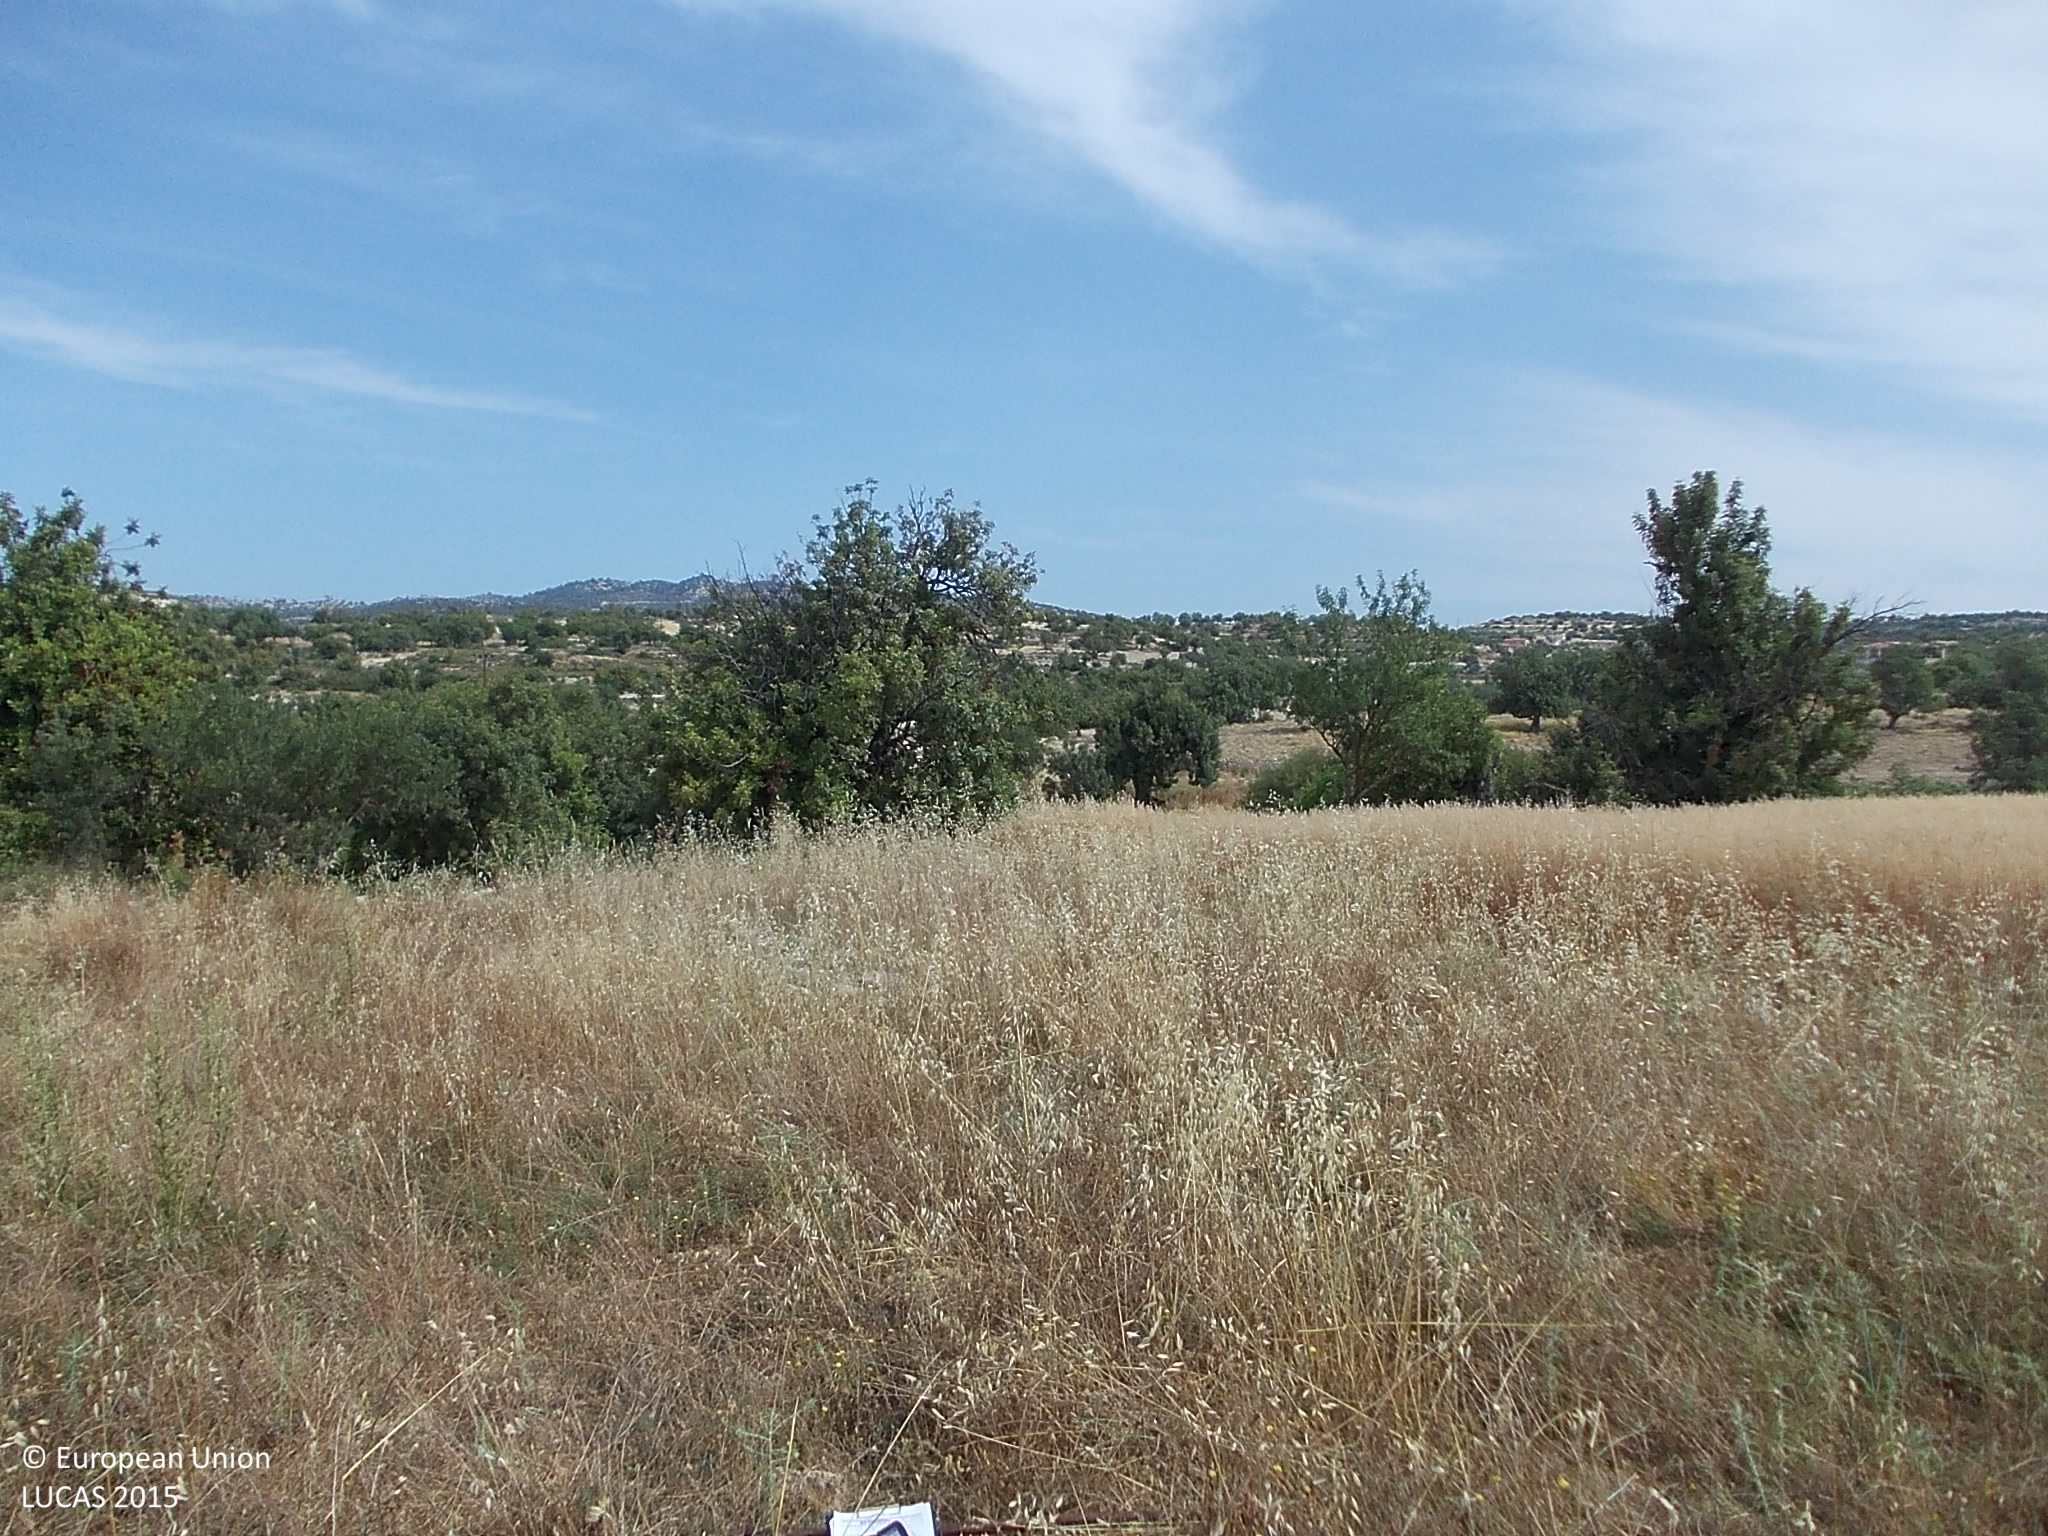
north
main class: Grassland
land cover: Spontaneously vegetated surfaces
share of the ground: > 75 %
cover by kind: herbaceous plants 90 %, unconsolidated bare surface 10 %
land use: Fallow land
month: May
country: CY
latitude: 34.7597
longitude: 32.9874
